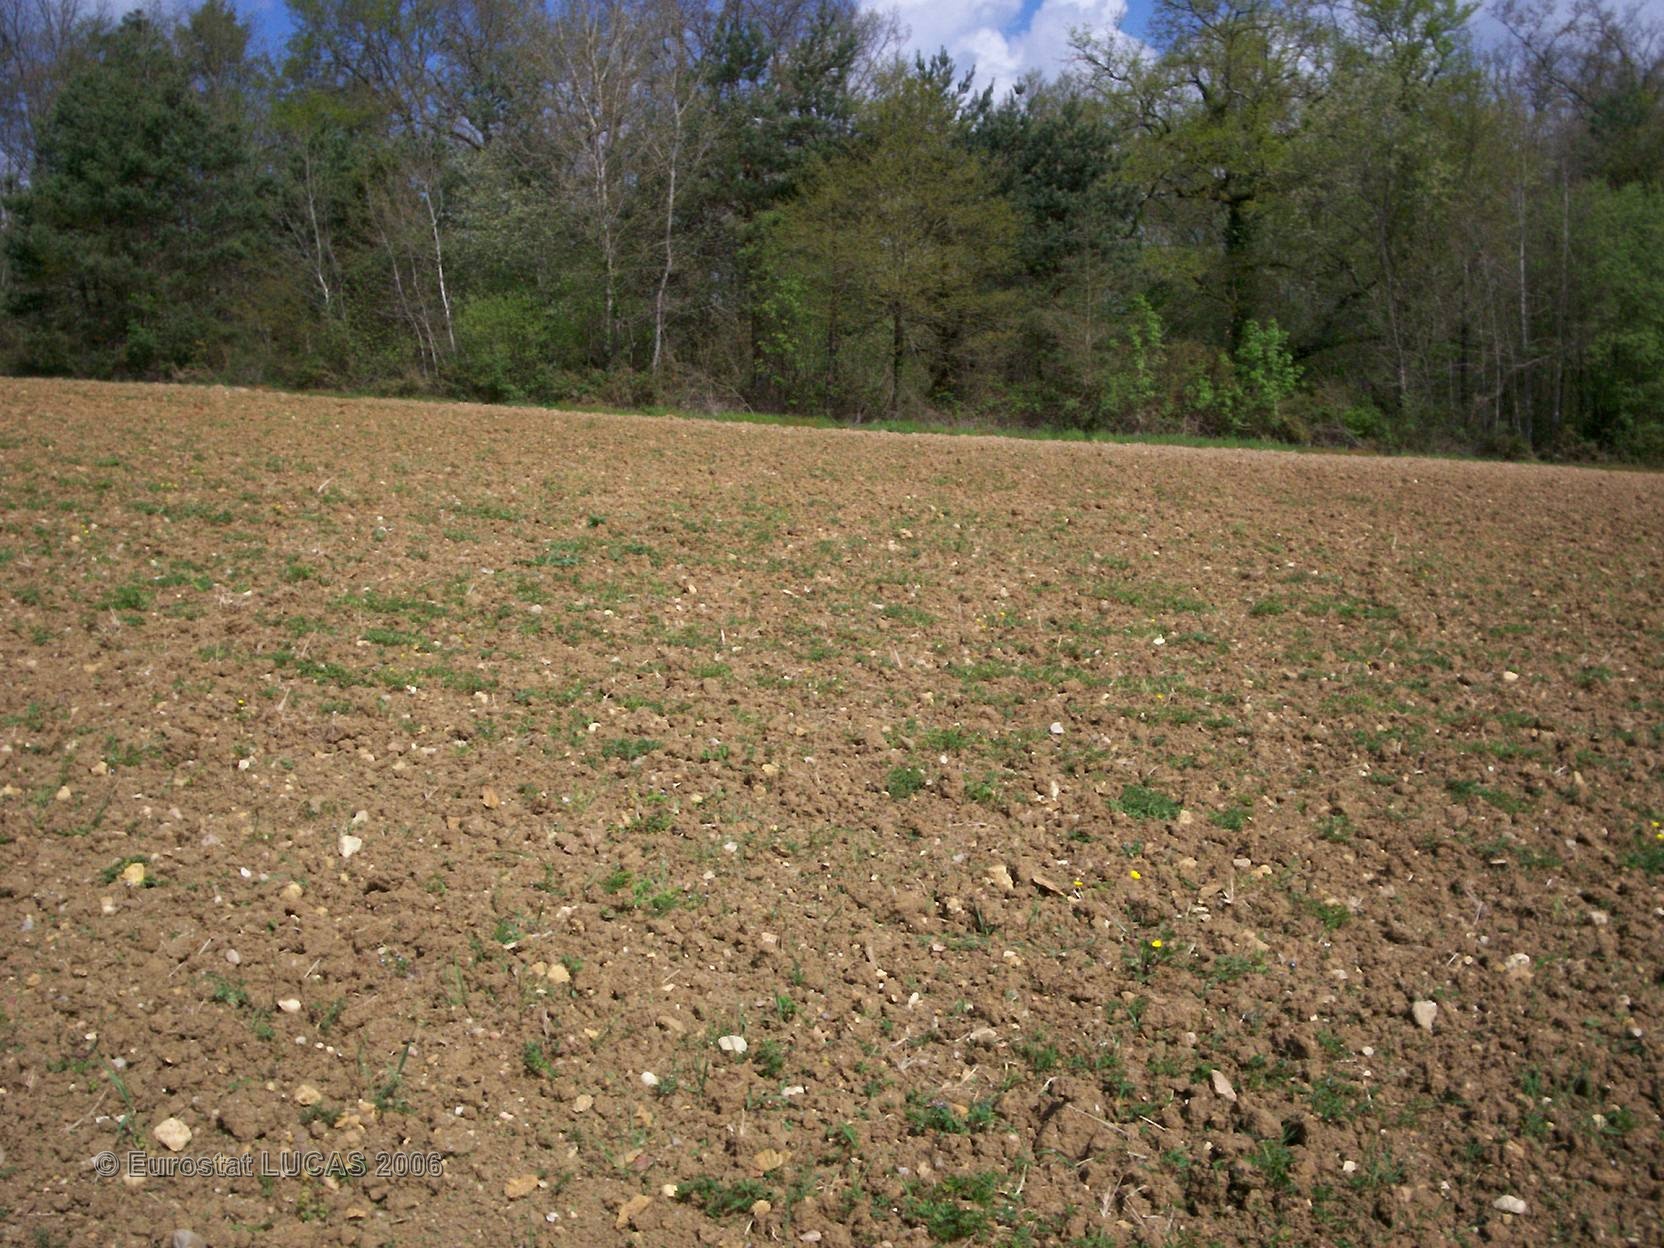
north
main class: Cropland
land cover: Maize
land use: Agriculture (excluding fallow land and kitchen gardens)
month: June
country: FR
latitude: 45.6246
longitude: 0.5598
